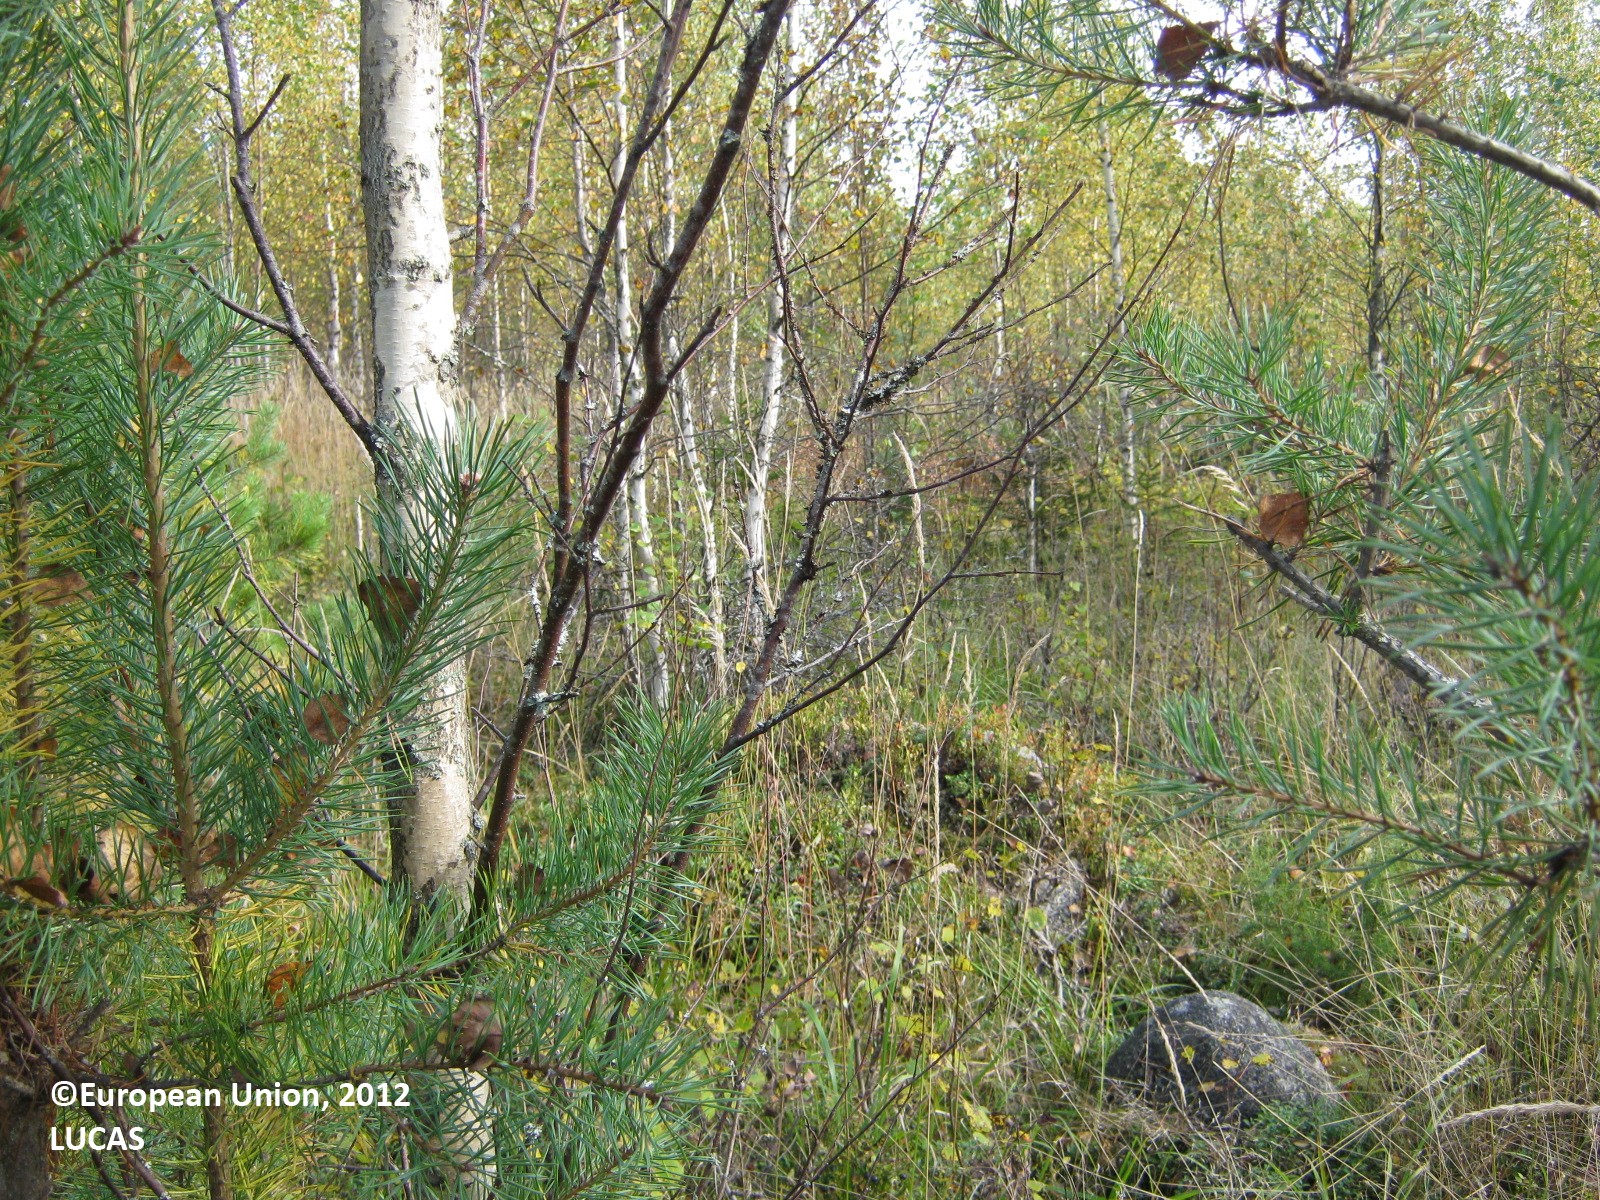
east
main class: Woodland
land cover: Other mixed woodland
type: boreal forest
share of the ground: 50 - 75 %
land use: Forestry
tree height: > 5 m
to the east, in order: Other mixed woodland; Broadleaved woodland; Spruce dominated coniferous woodland
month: September
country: FI
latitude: 60.9564
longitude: 28.1341
